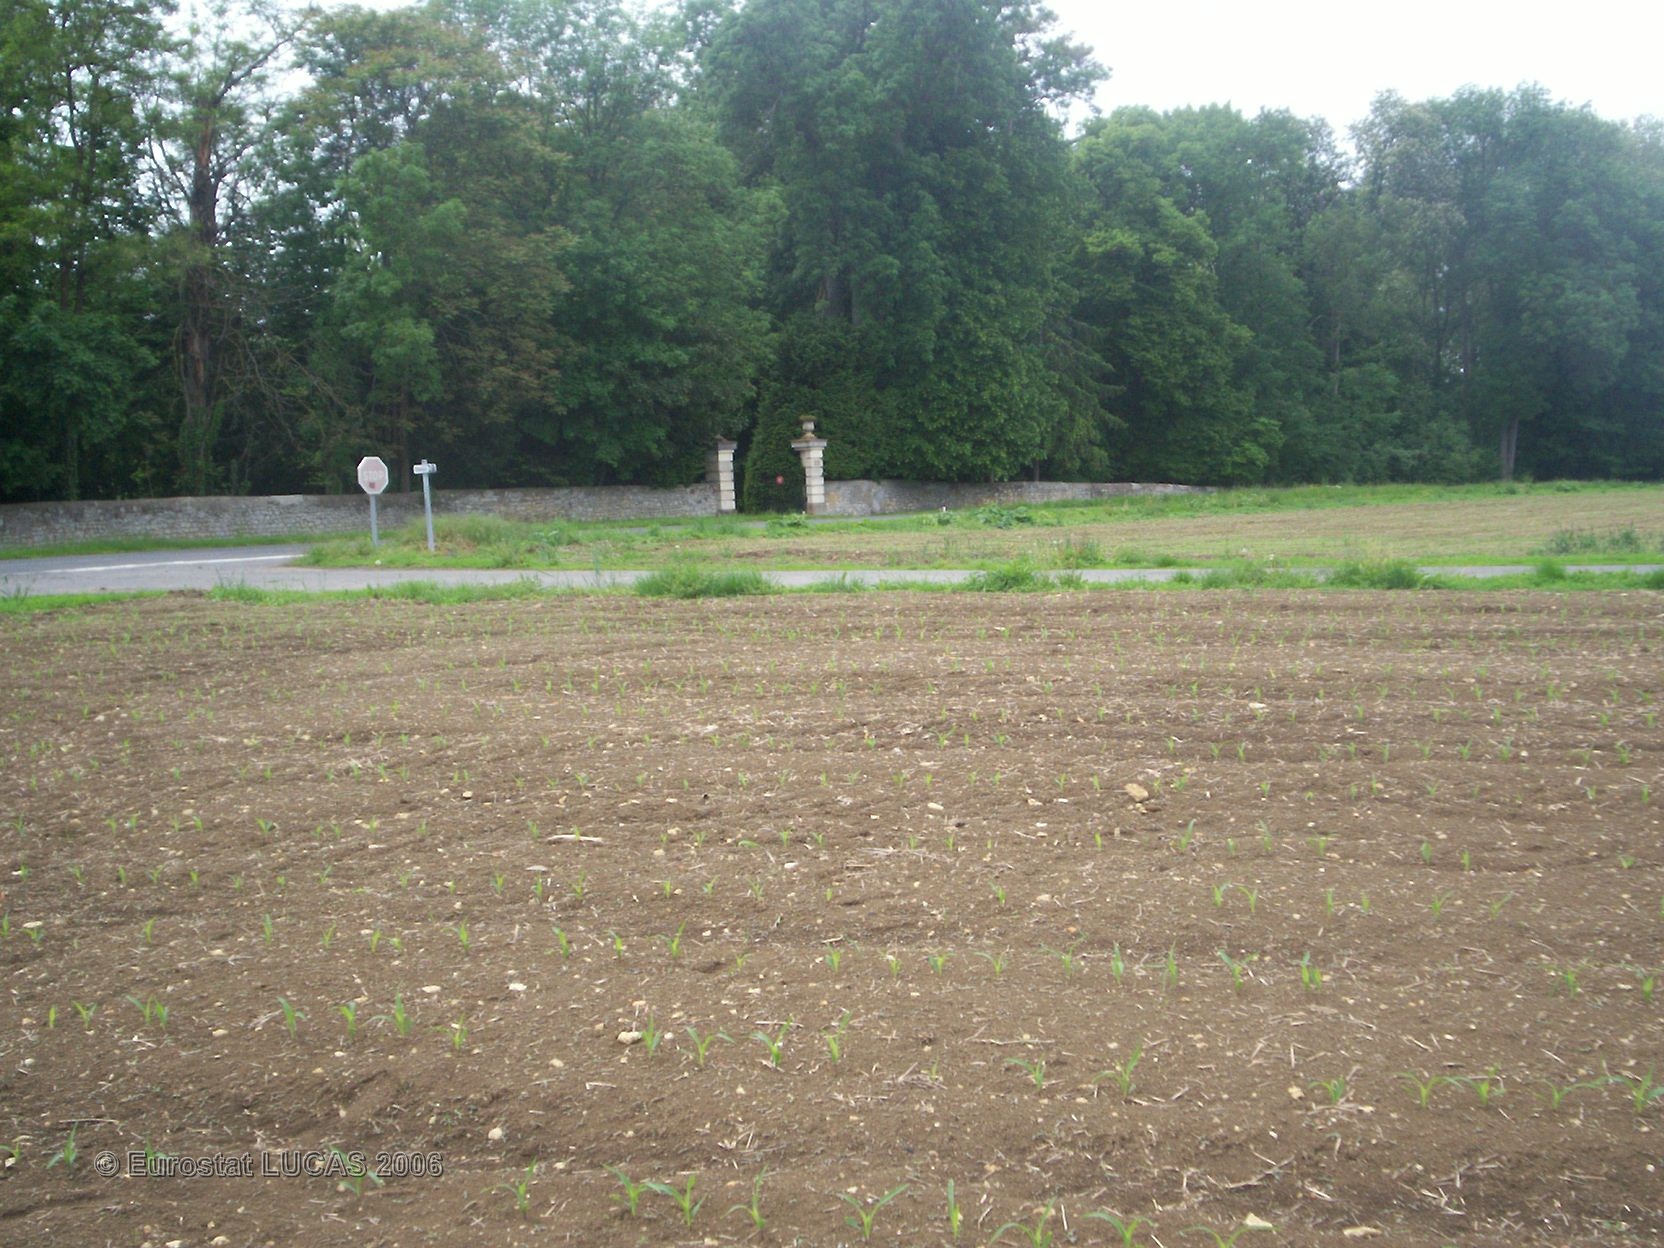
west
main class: Cropland
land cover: Maize
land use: Agriculture (excluding fallow land and kitchen gardens)
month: May
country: FR
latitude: 46.0828
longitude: 3.2359
